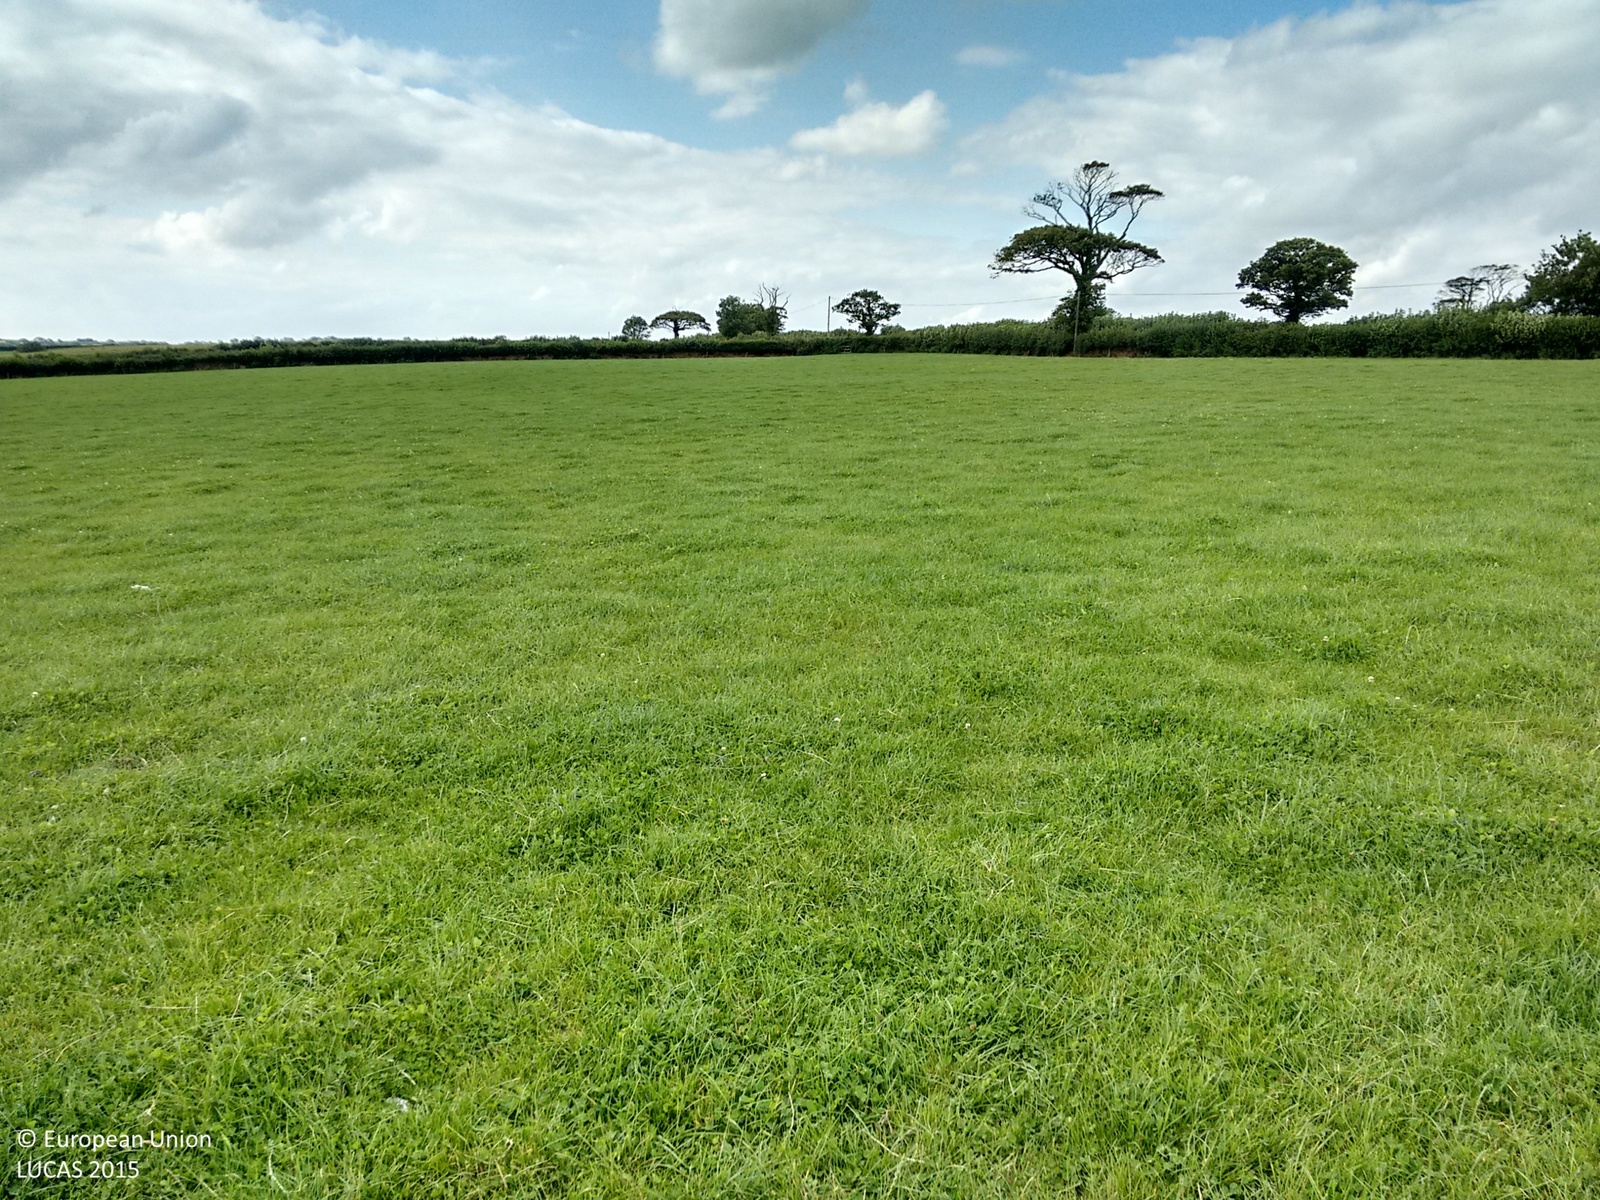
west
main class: Grassland
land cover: Grassland without tree/shrub cover
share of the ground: > 75 %
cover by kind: herbaceous plants 100 %
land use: Agriculture (excluding fallow land and kitchen gardens)
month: September
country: GB
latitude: 50.9195
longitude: -4.3116
